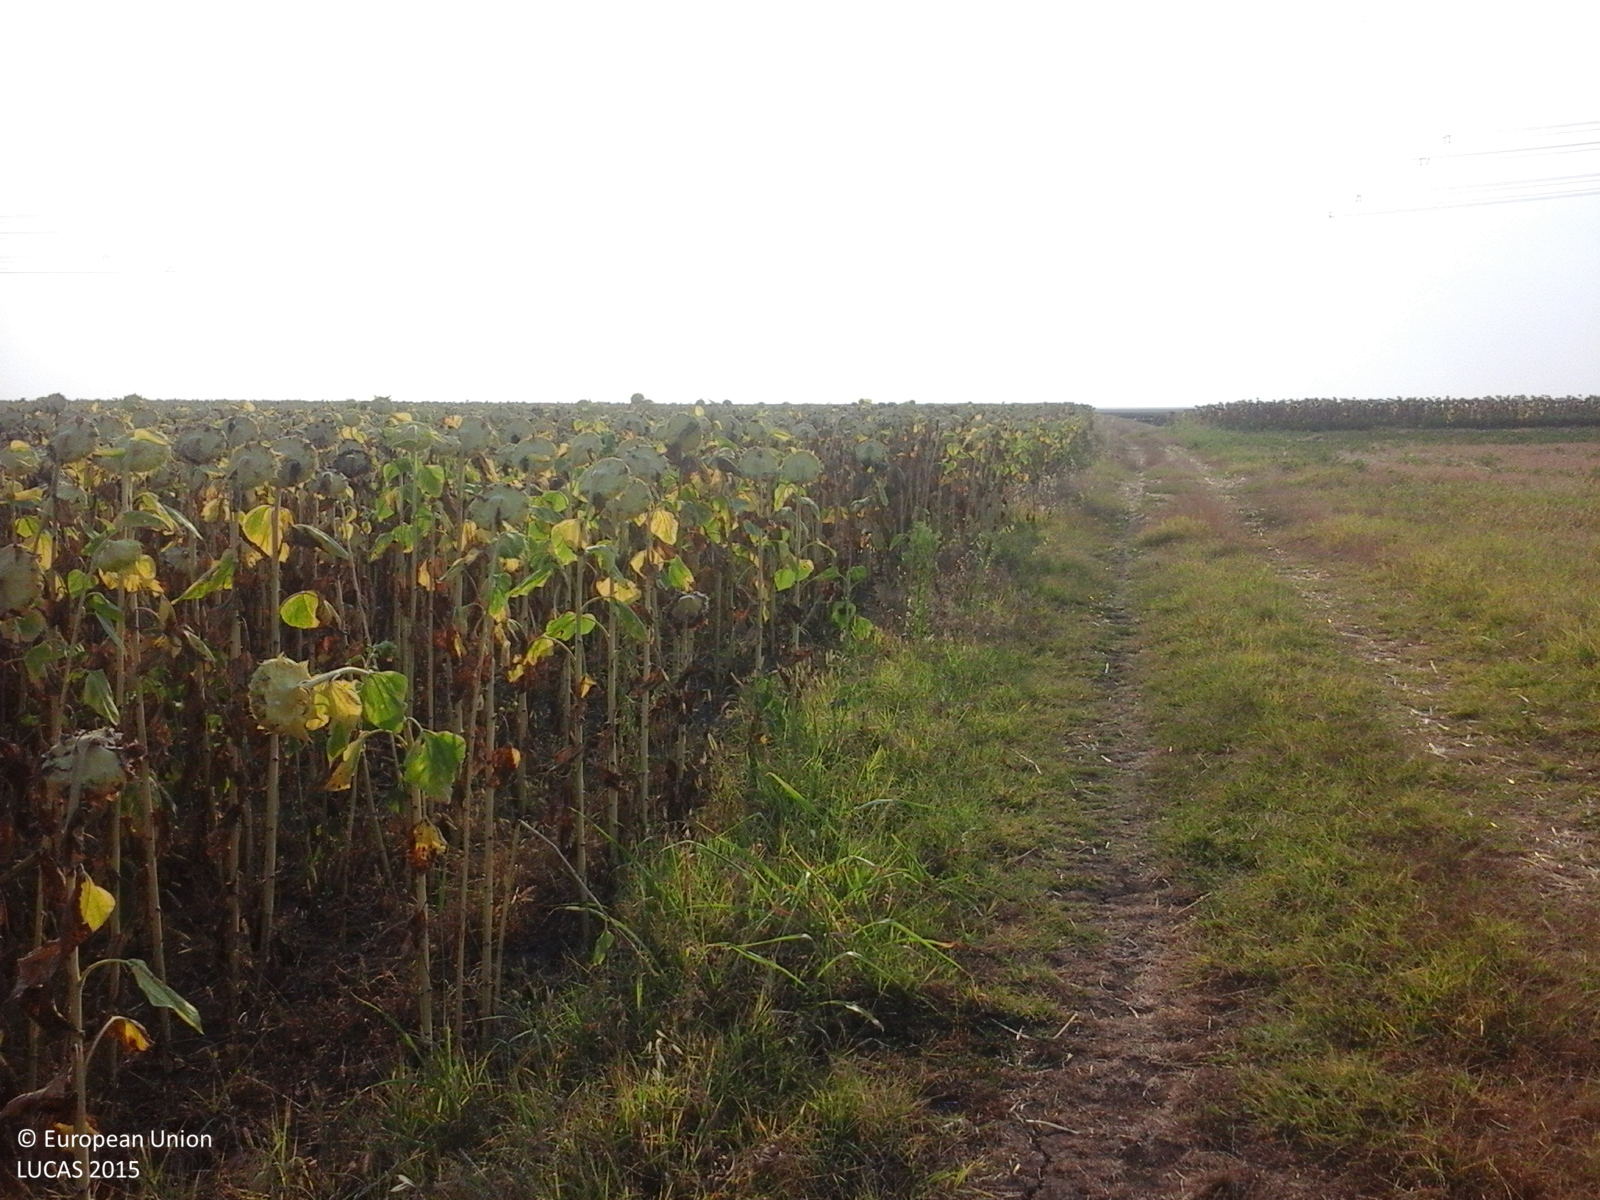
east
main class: Cropland
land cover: Sunflower
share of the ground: > 75 %
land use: Agriculture (excluding fallow land and kitchen gardens)
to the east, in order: Sunflower; Electric lines; Sunflower
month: August
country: RO
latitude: 44.0089
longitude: 23.6595
